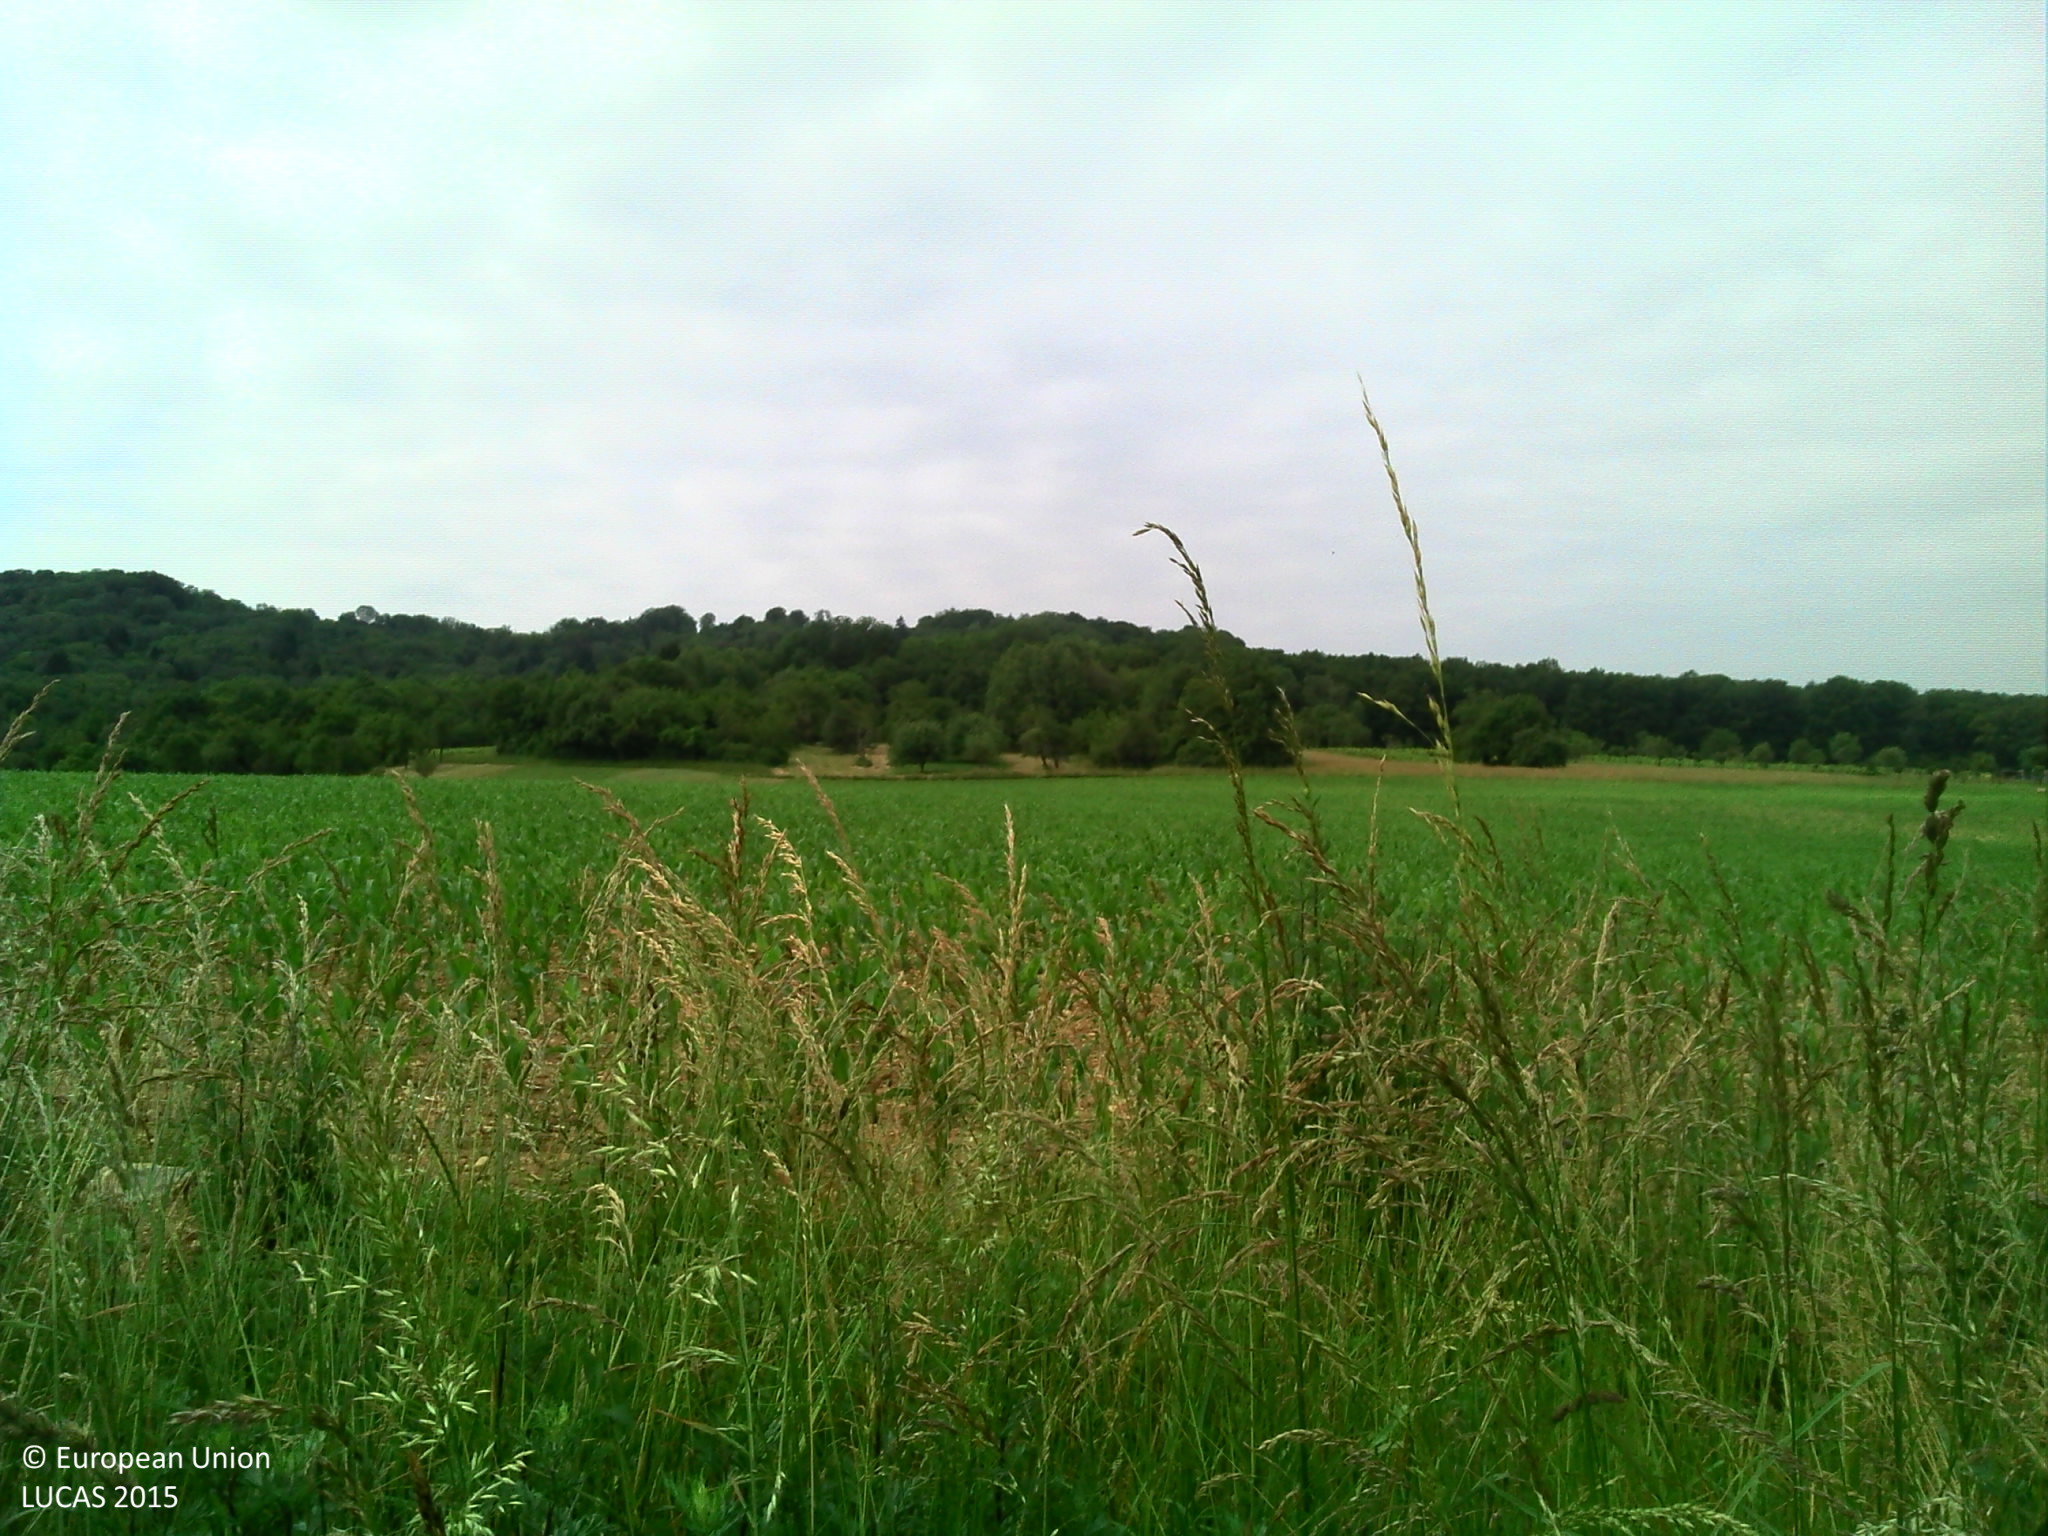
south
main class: Cropland
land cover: Common wheat
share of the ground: > 75 %
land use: Agriculture (excluding fallow land and kitchen gardens)
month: June
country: FR
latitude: 47.7491
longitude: 6.3599
